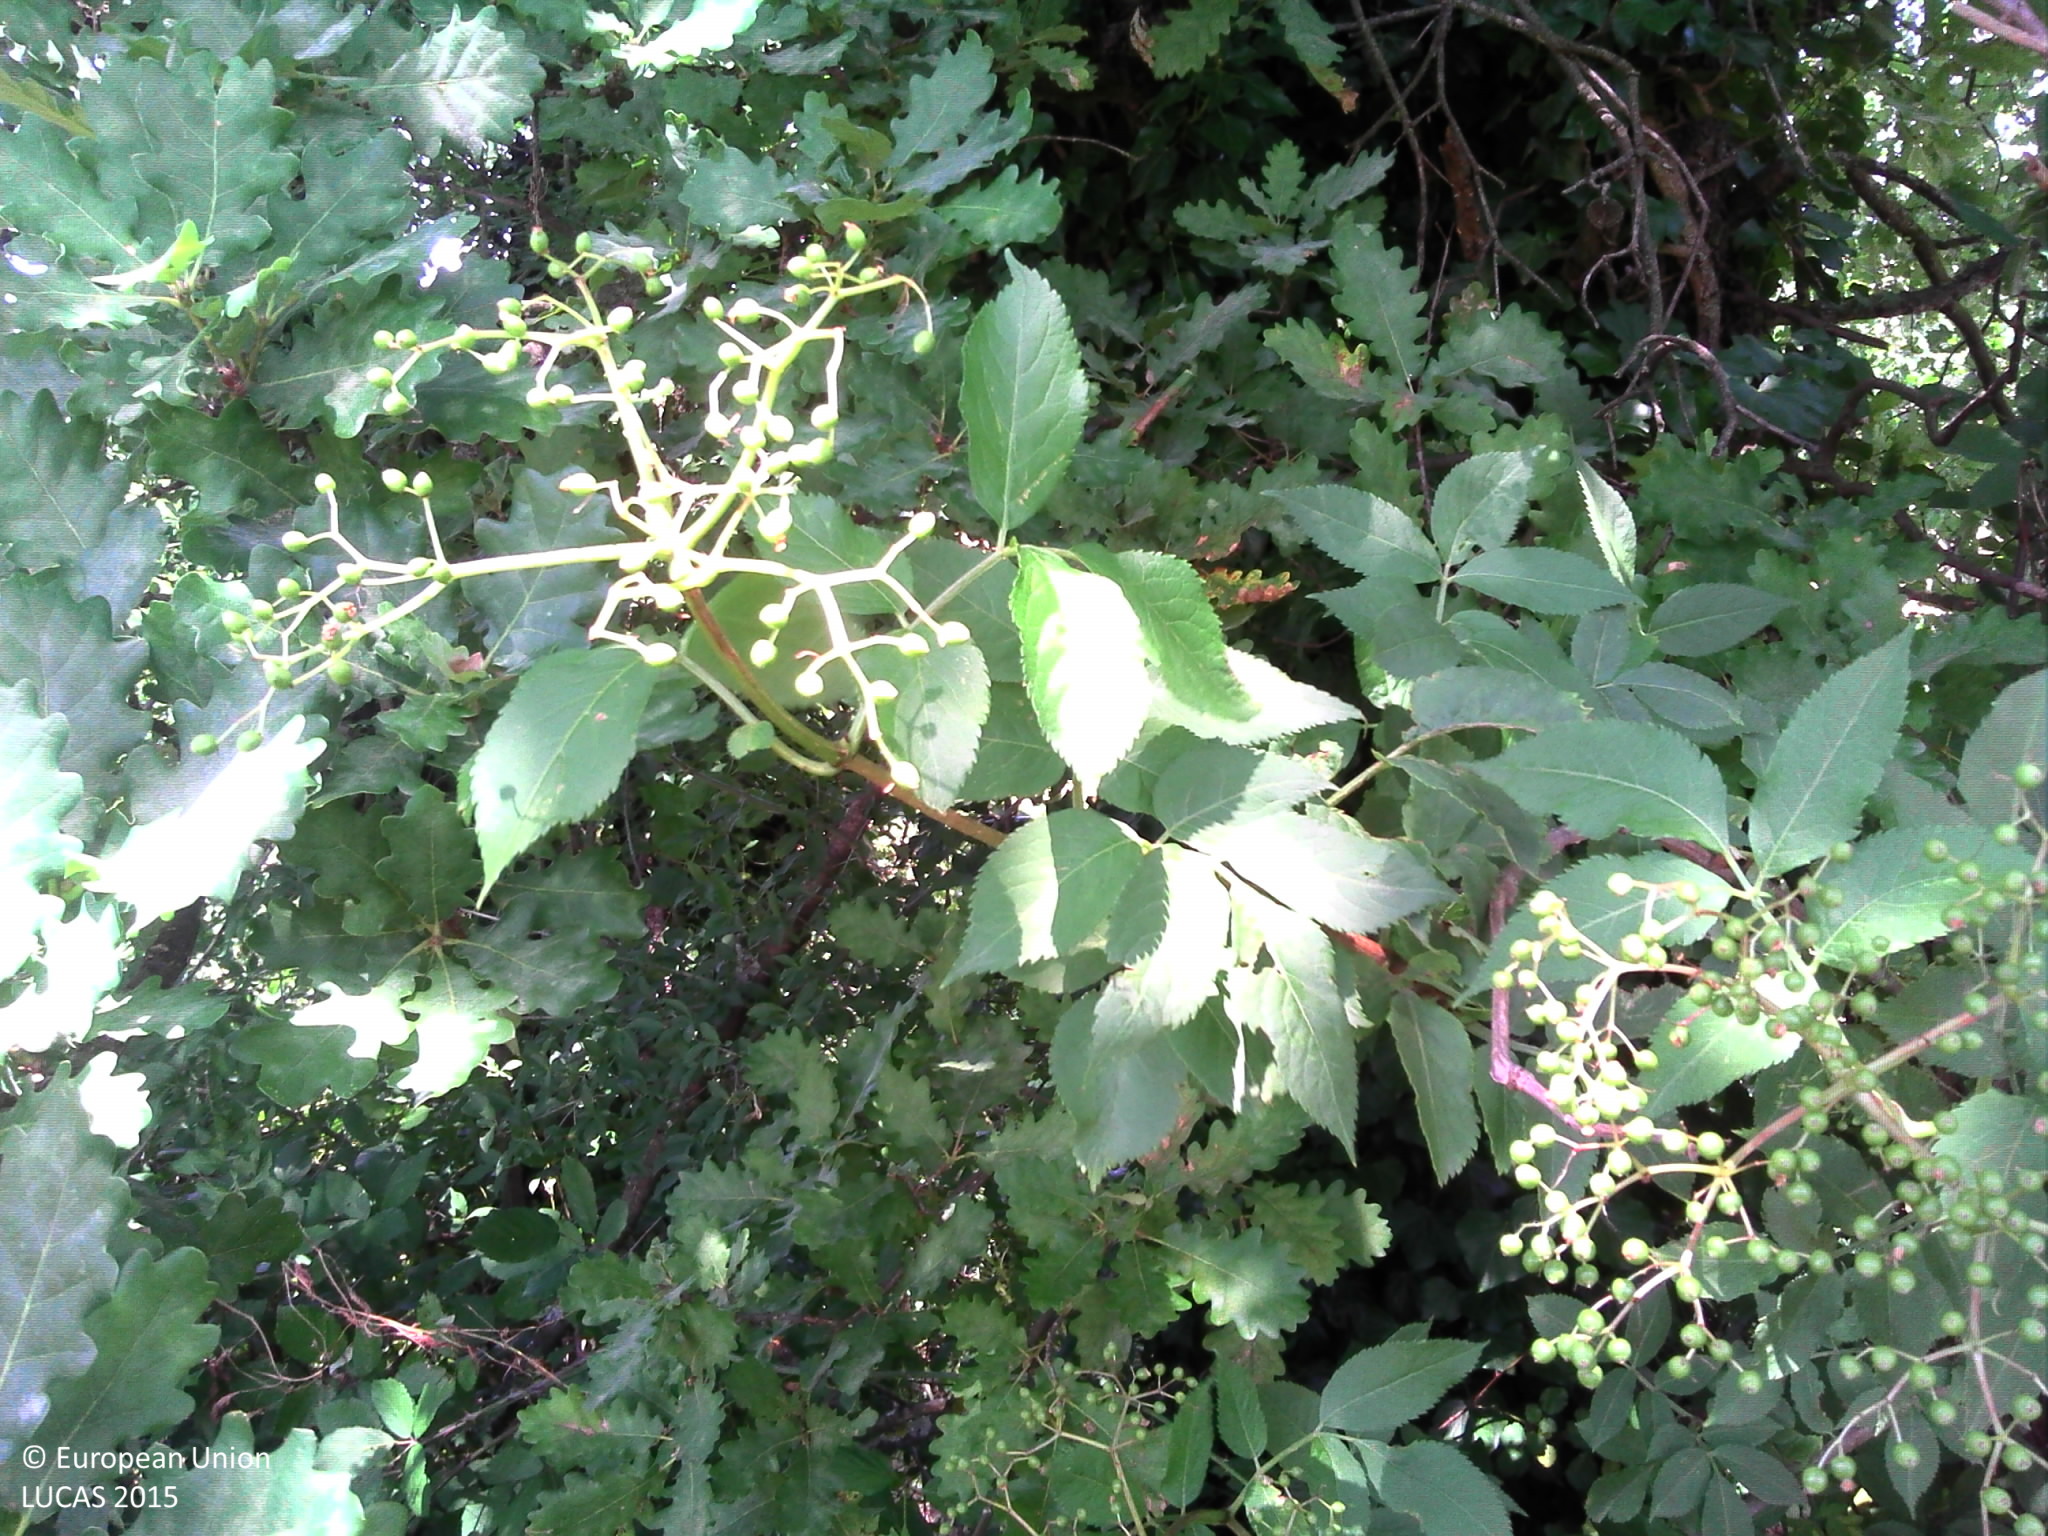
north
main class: Woodland
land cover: Broadleaved woodland
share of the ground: > 75 %
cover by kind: broadleaved forest trees 95 %, herbaceous plants 5 %
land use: Semi-natural and natural areas not in use
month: June
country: FR
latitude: 44.8410
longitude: 4.9330
